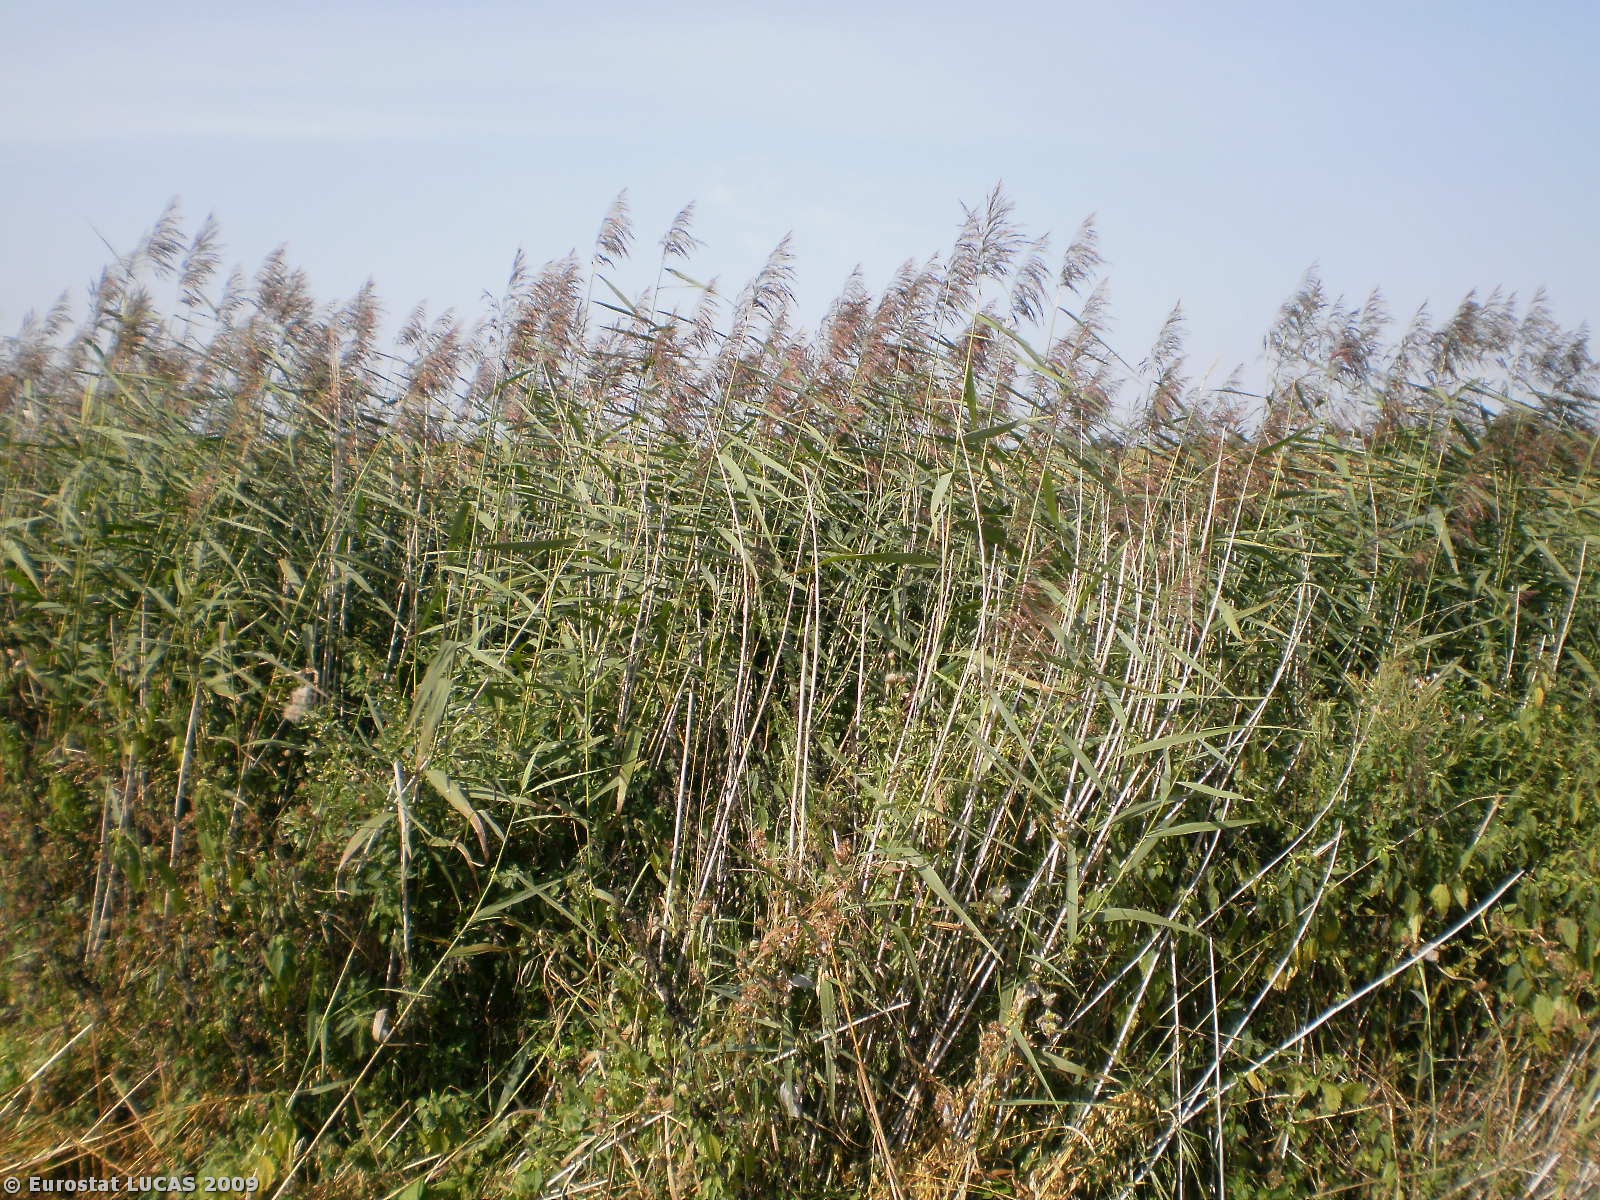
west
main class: Cropland
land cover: Oats
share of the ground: > 75 %
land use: Agriculture (excluding fallow land and kitchen gardens)
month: August
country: PL
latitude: 54.3033
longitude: 21.7160
